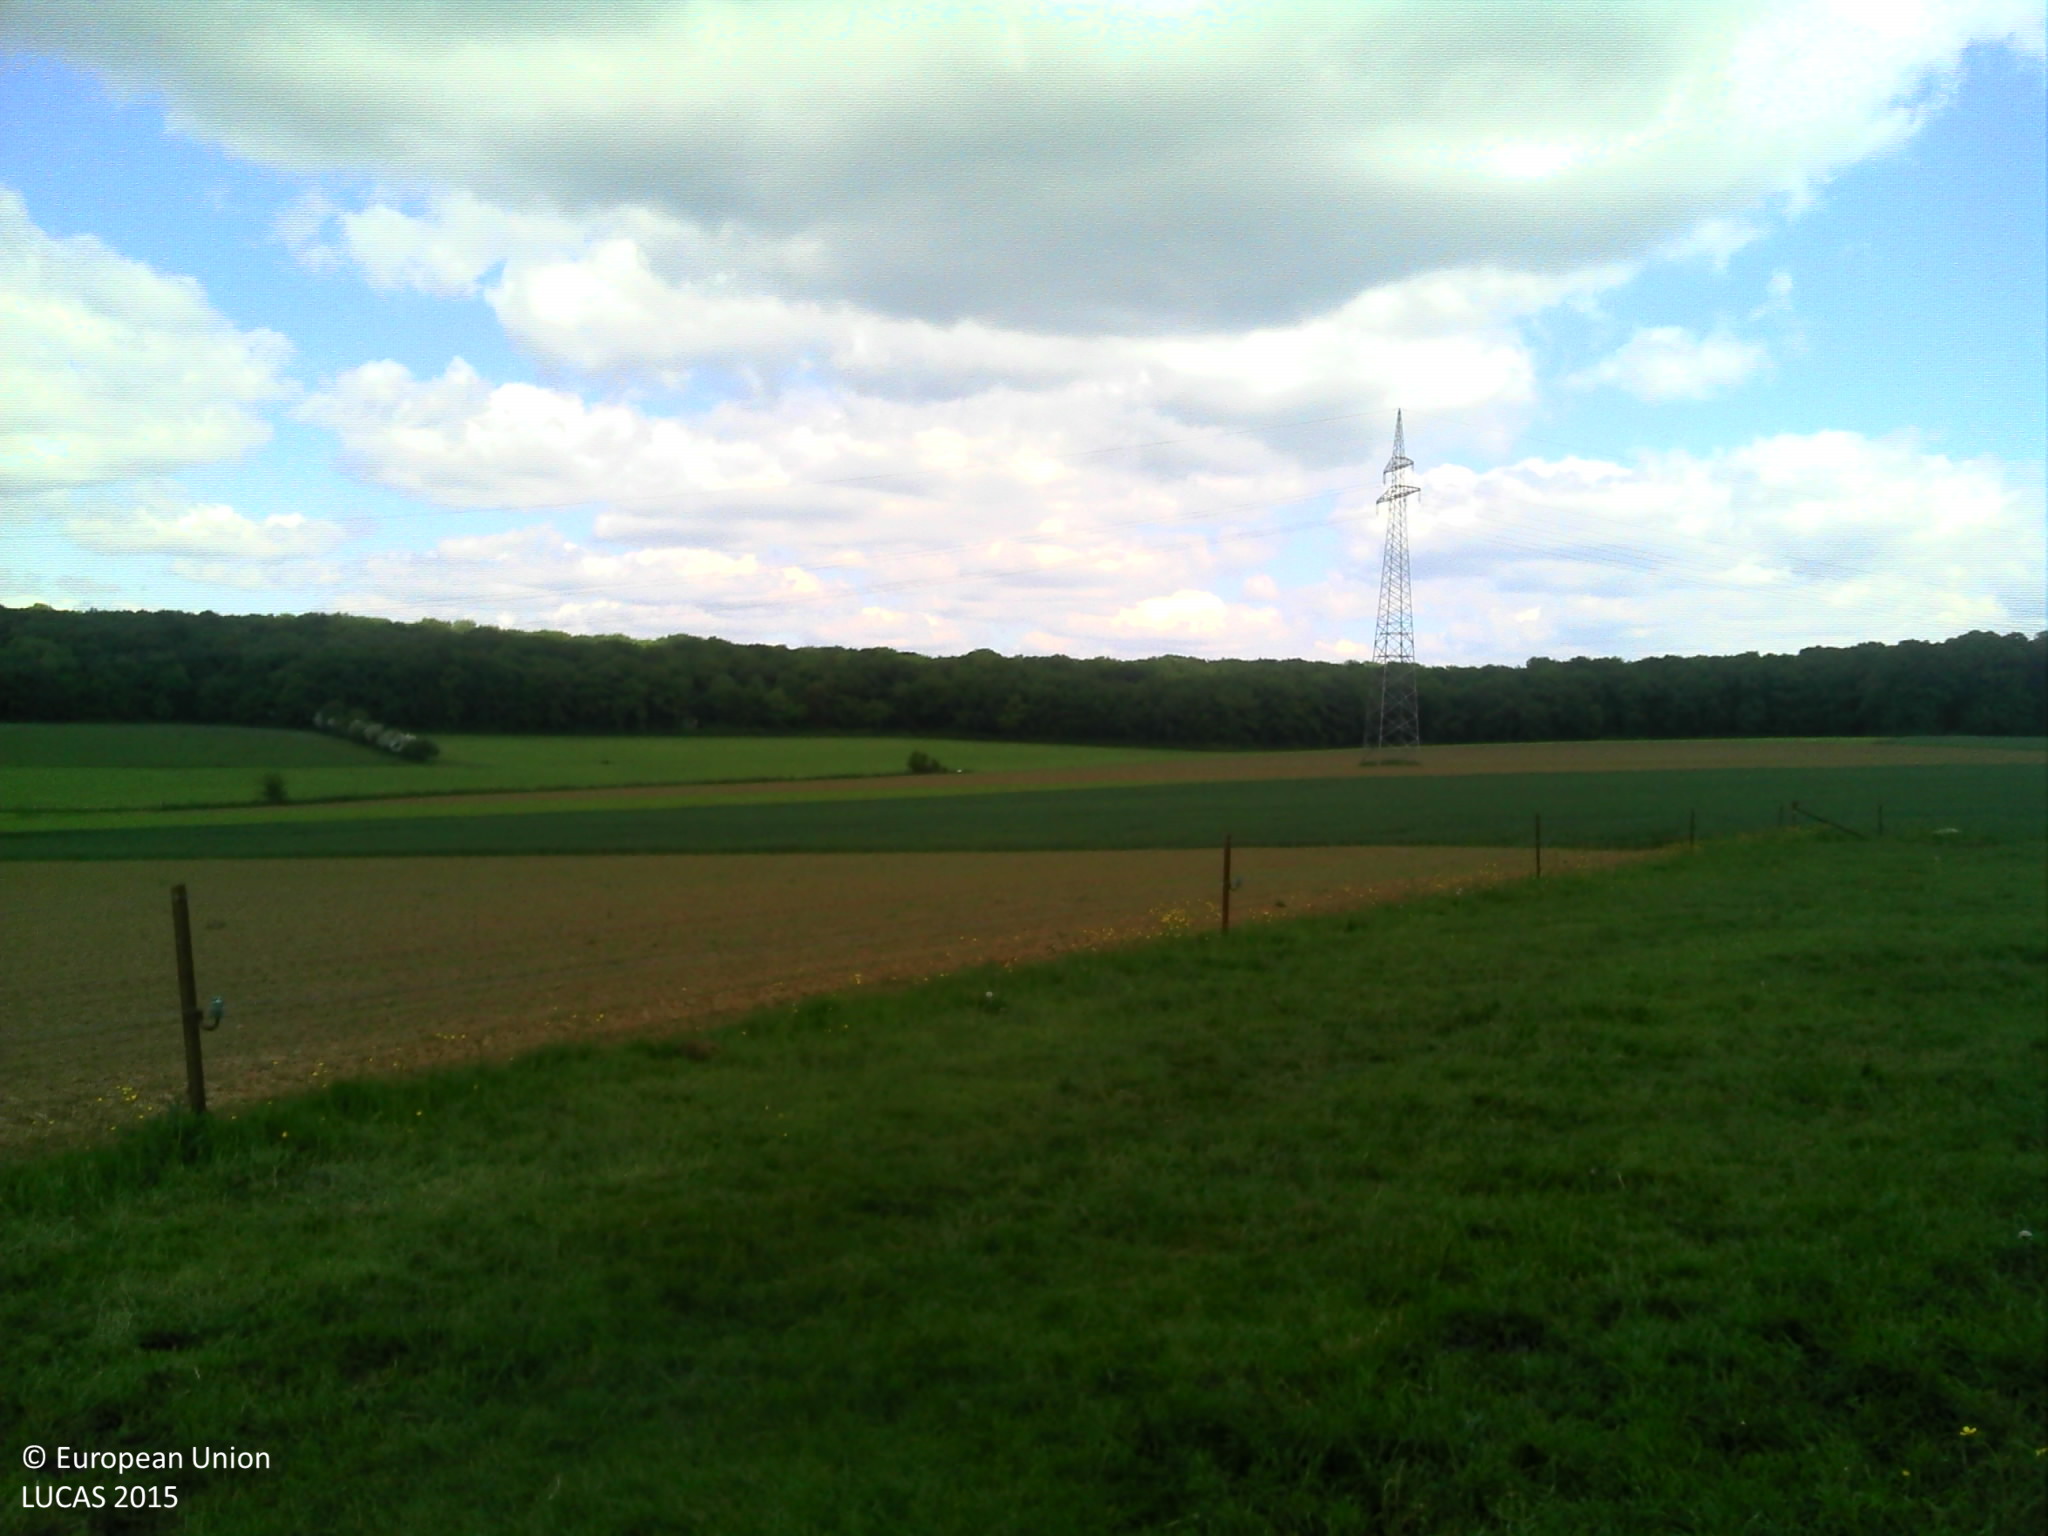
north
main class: Grassland
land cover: Grassland without tree/shrub cover
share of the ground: > 75 %
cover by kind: herbaceous plants 100 %
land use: Agriculture (excluding fallow land and kitchen gardens)
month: May
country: LU
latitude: 49.8026
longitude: 6.3733
